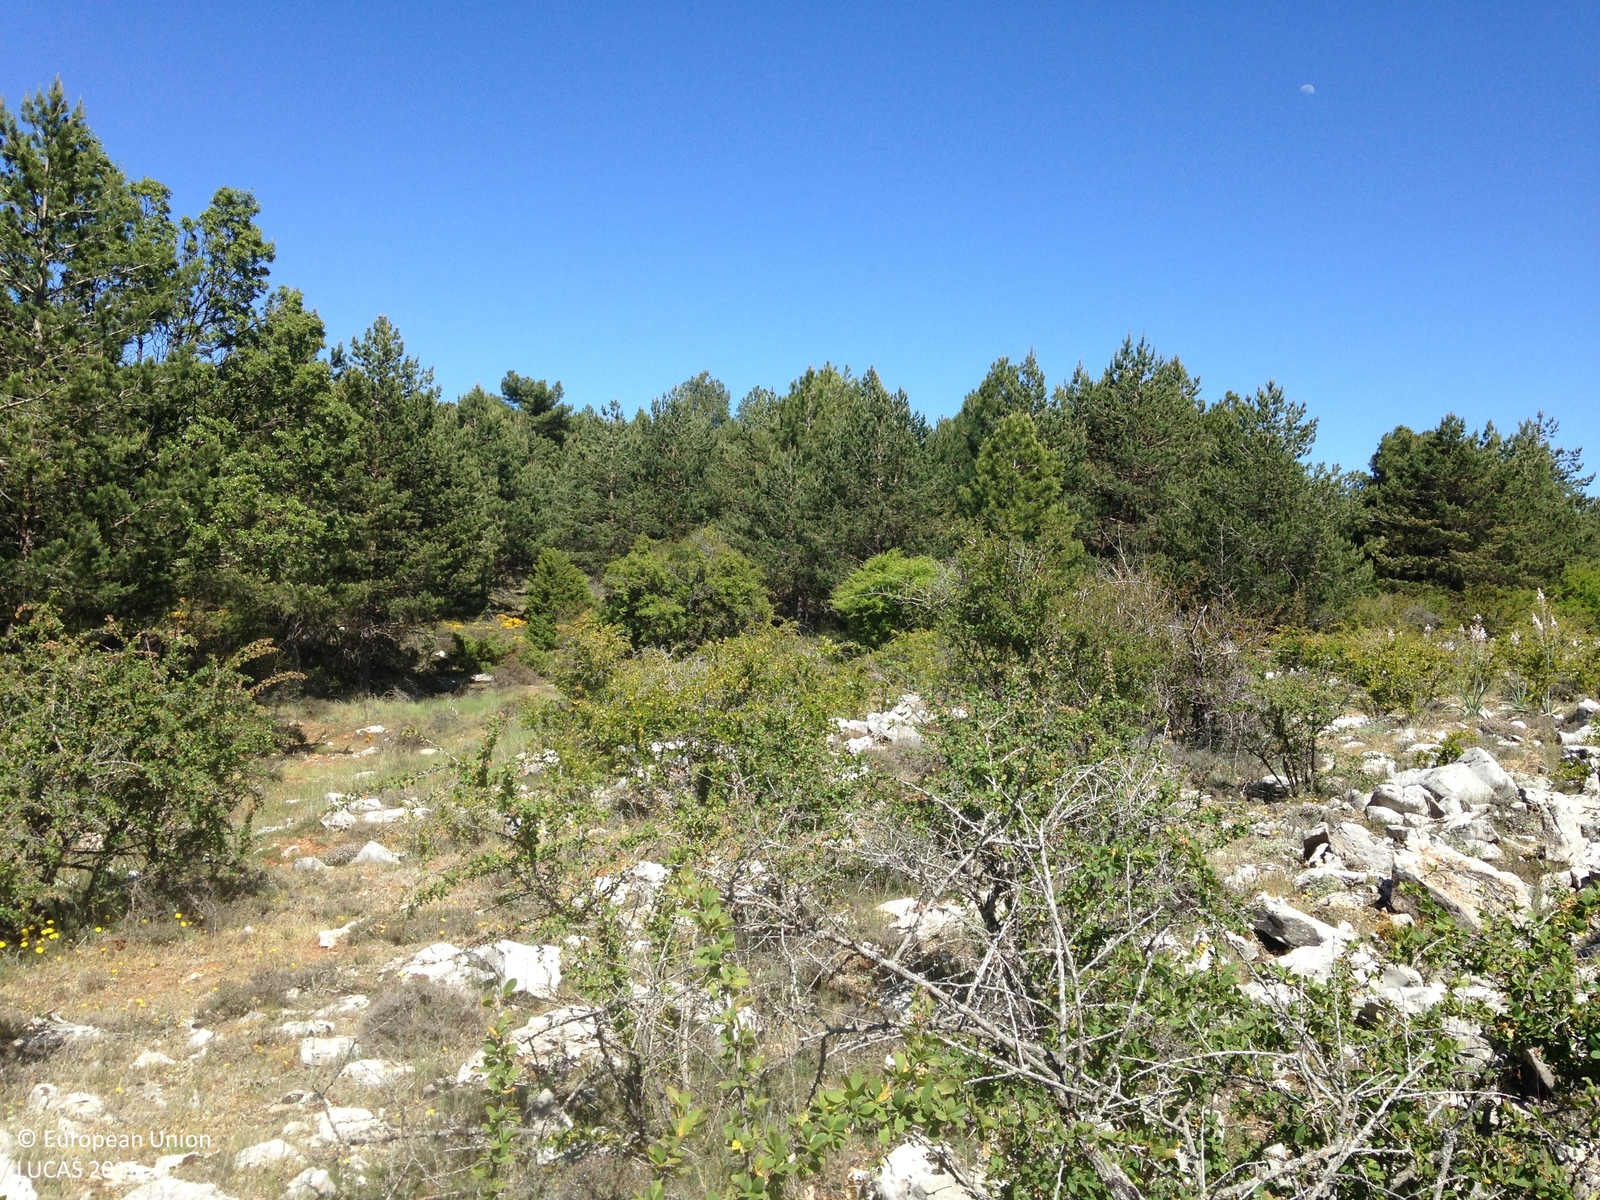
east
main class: Shrubland
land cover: Shrubland without tree cover
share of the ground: 50 - 75 %
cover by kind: shrubs 50 %, herbaceous plants 30 %, consolidated bare surface 10 %, unconsolidated bare surface 10 %
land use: Semi-natural and natural areas not in use
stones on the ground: > 50 %
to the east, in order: Shrubland without tree cover; Pine dominated coniferous woodland; Tracks; Pine dominated coniferous woodland; Other bare soil; Shrubland without tree cover
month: May
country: ES
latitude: 40.6008
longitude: -2.0393
